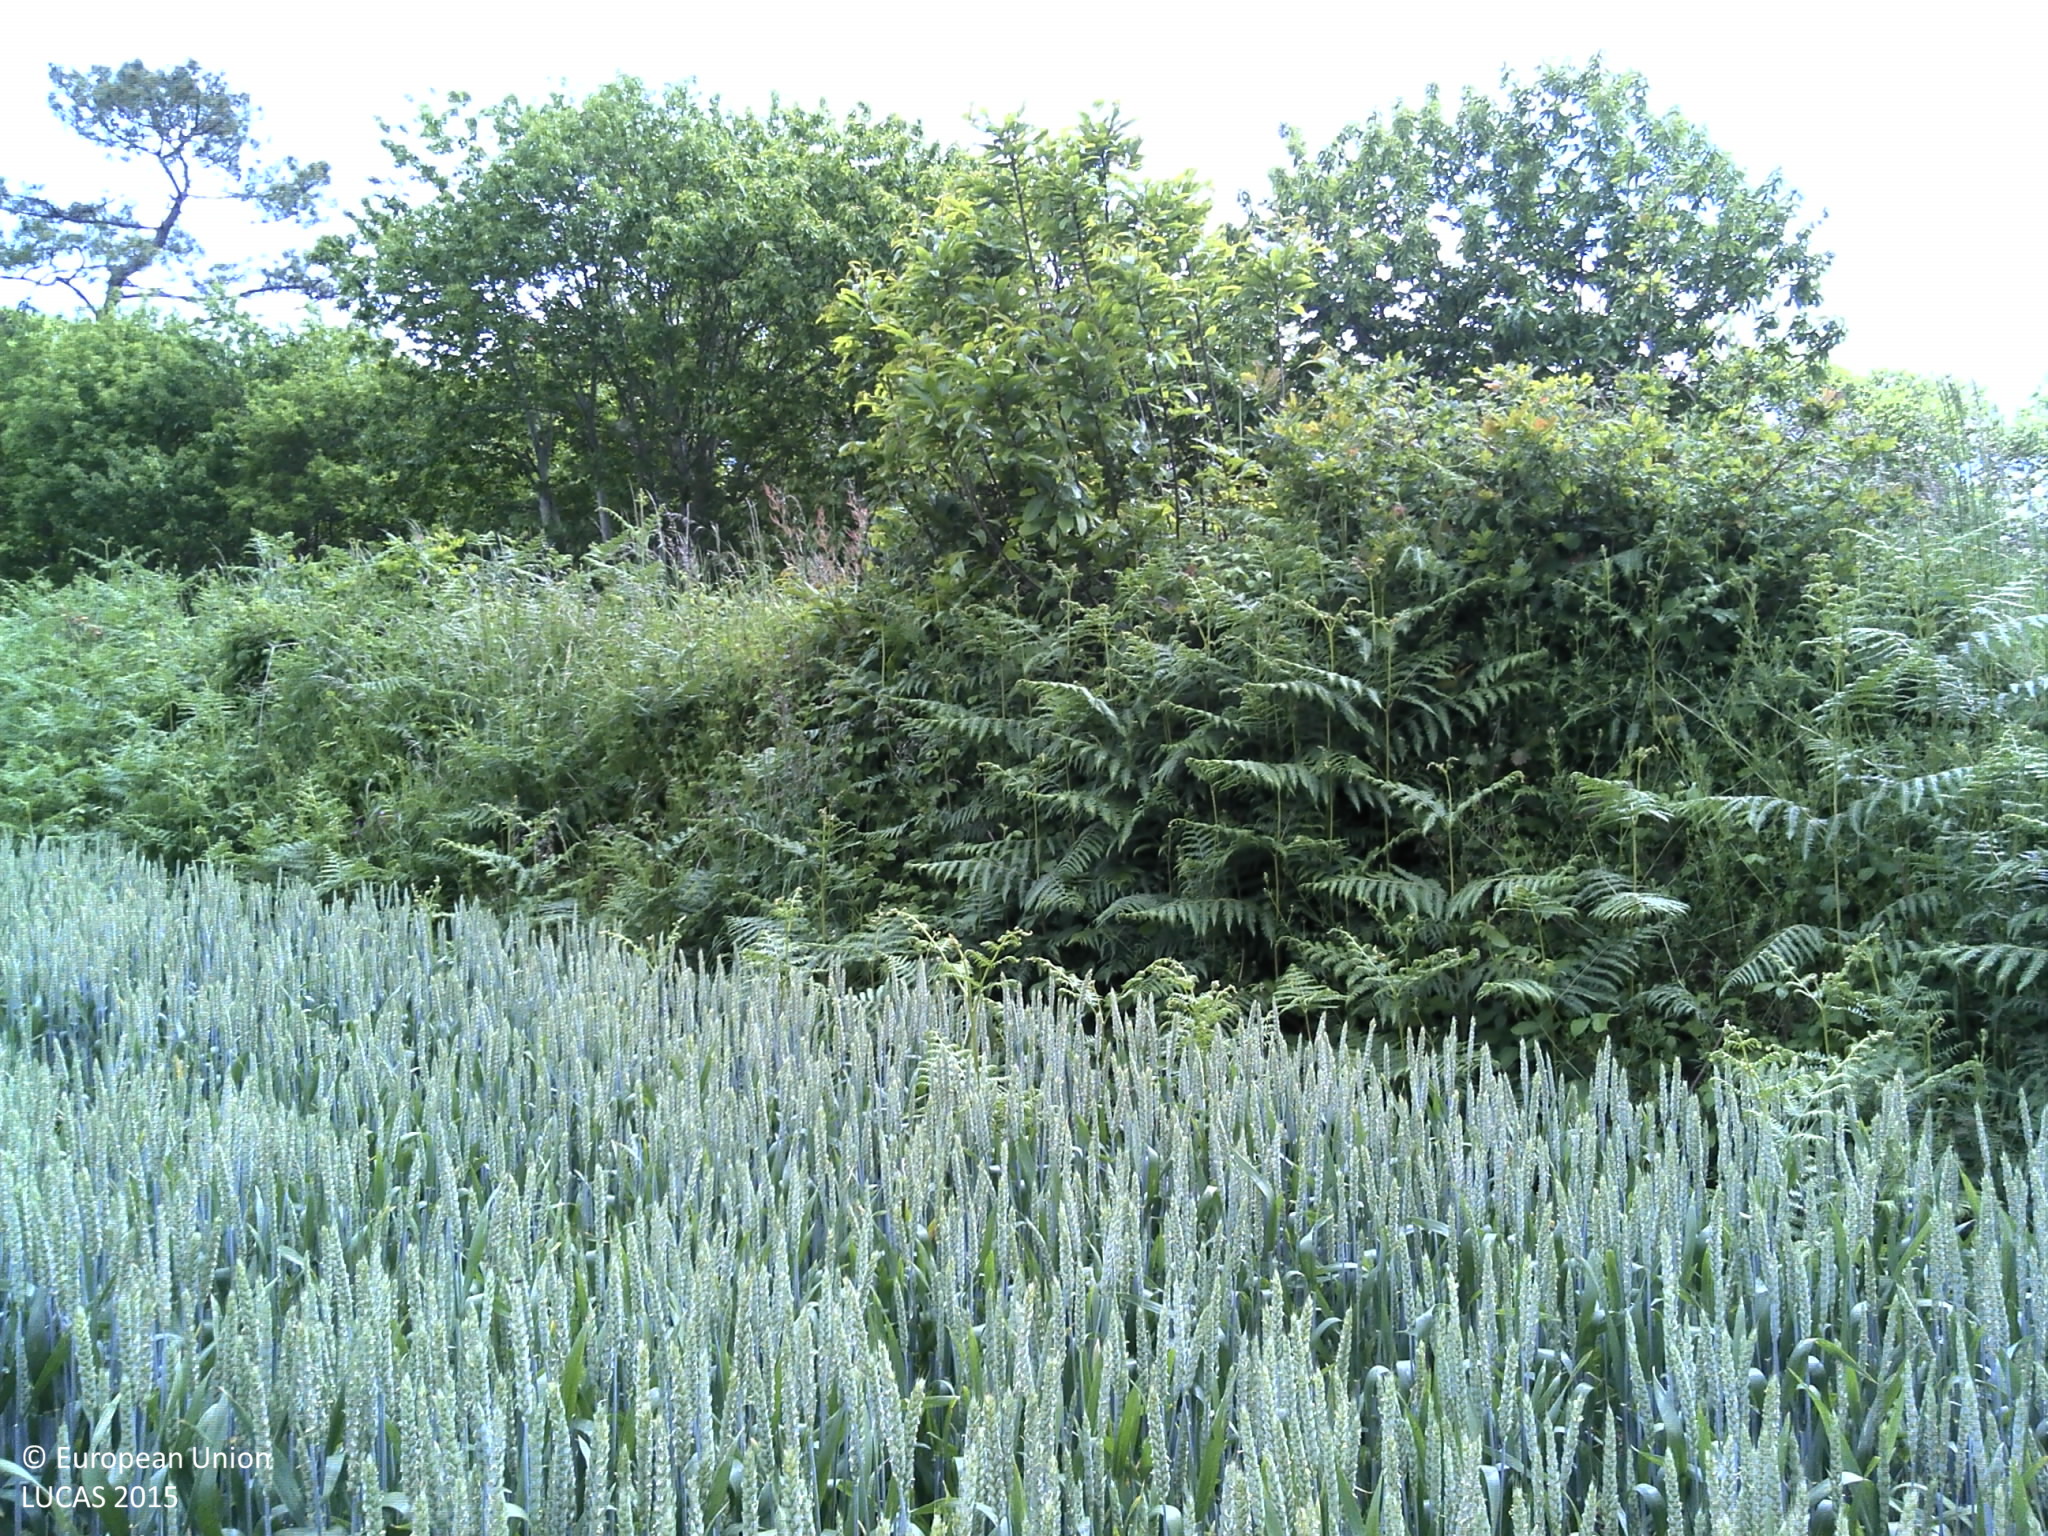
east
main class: Cropland
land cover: Common wheat
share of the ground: > 75 %
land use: Agriculture (excluding fallow land and kitchen gardens)
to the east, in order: Common wheat; Abandoned hedges; Ditches and canals; Grass margins; Paved roads, cycling and walking lanes; Grass margins; Ditches and canals; Managed hedges; Grassland without tree/shrub cover; Lines of trees; Maize; Dry stone walls; Lines of trees; Shrubland with sparse tree cover; Lines of trees; Dry stone walls; Tracks; Grassland without tree/shrub cover; Fences; Lines of trees; Maize
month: June
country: FR
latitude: 47.9530
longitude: -3.5071
